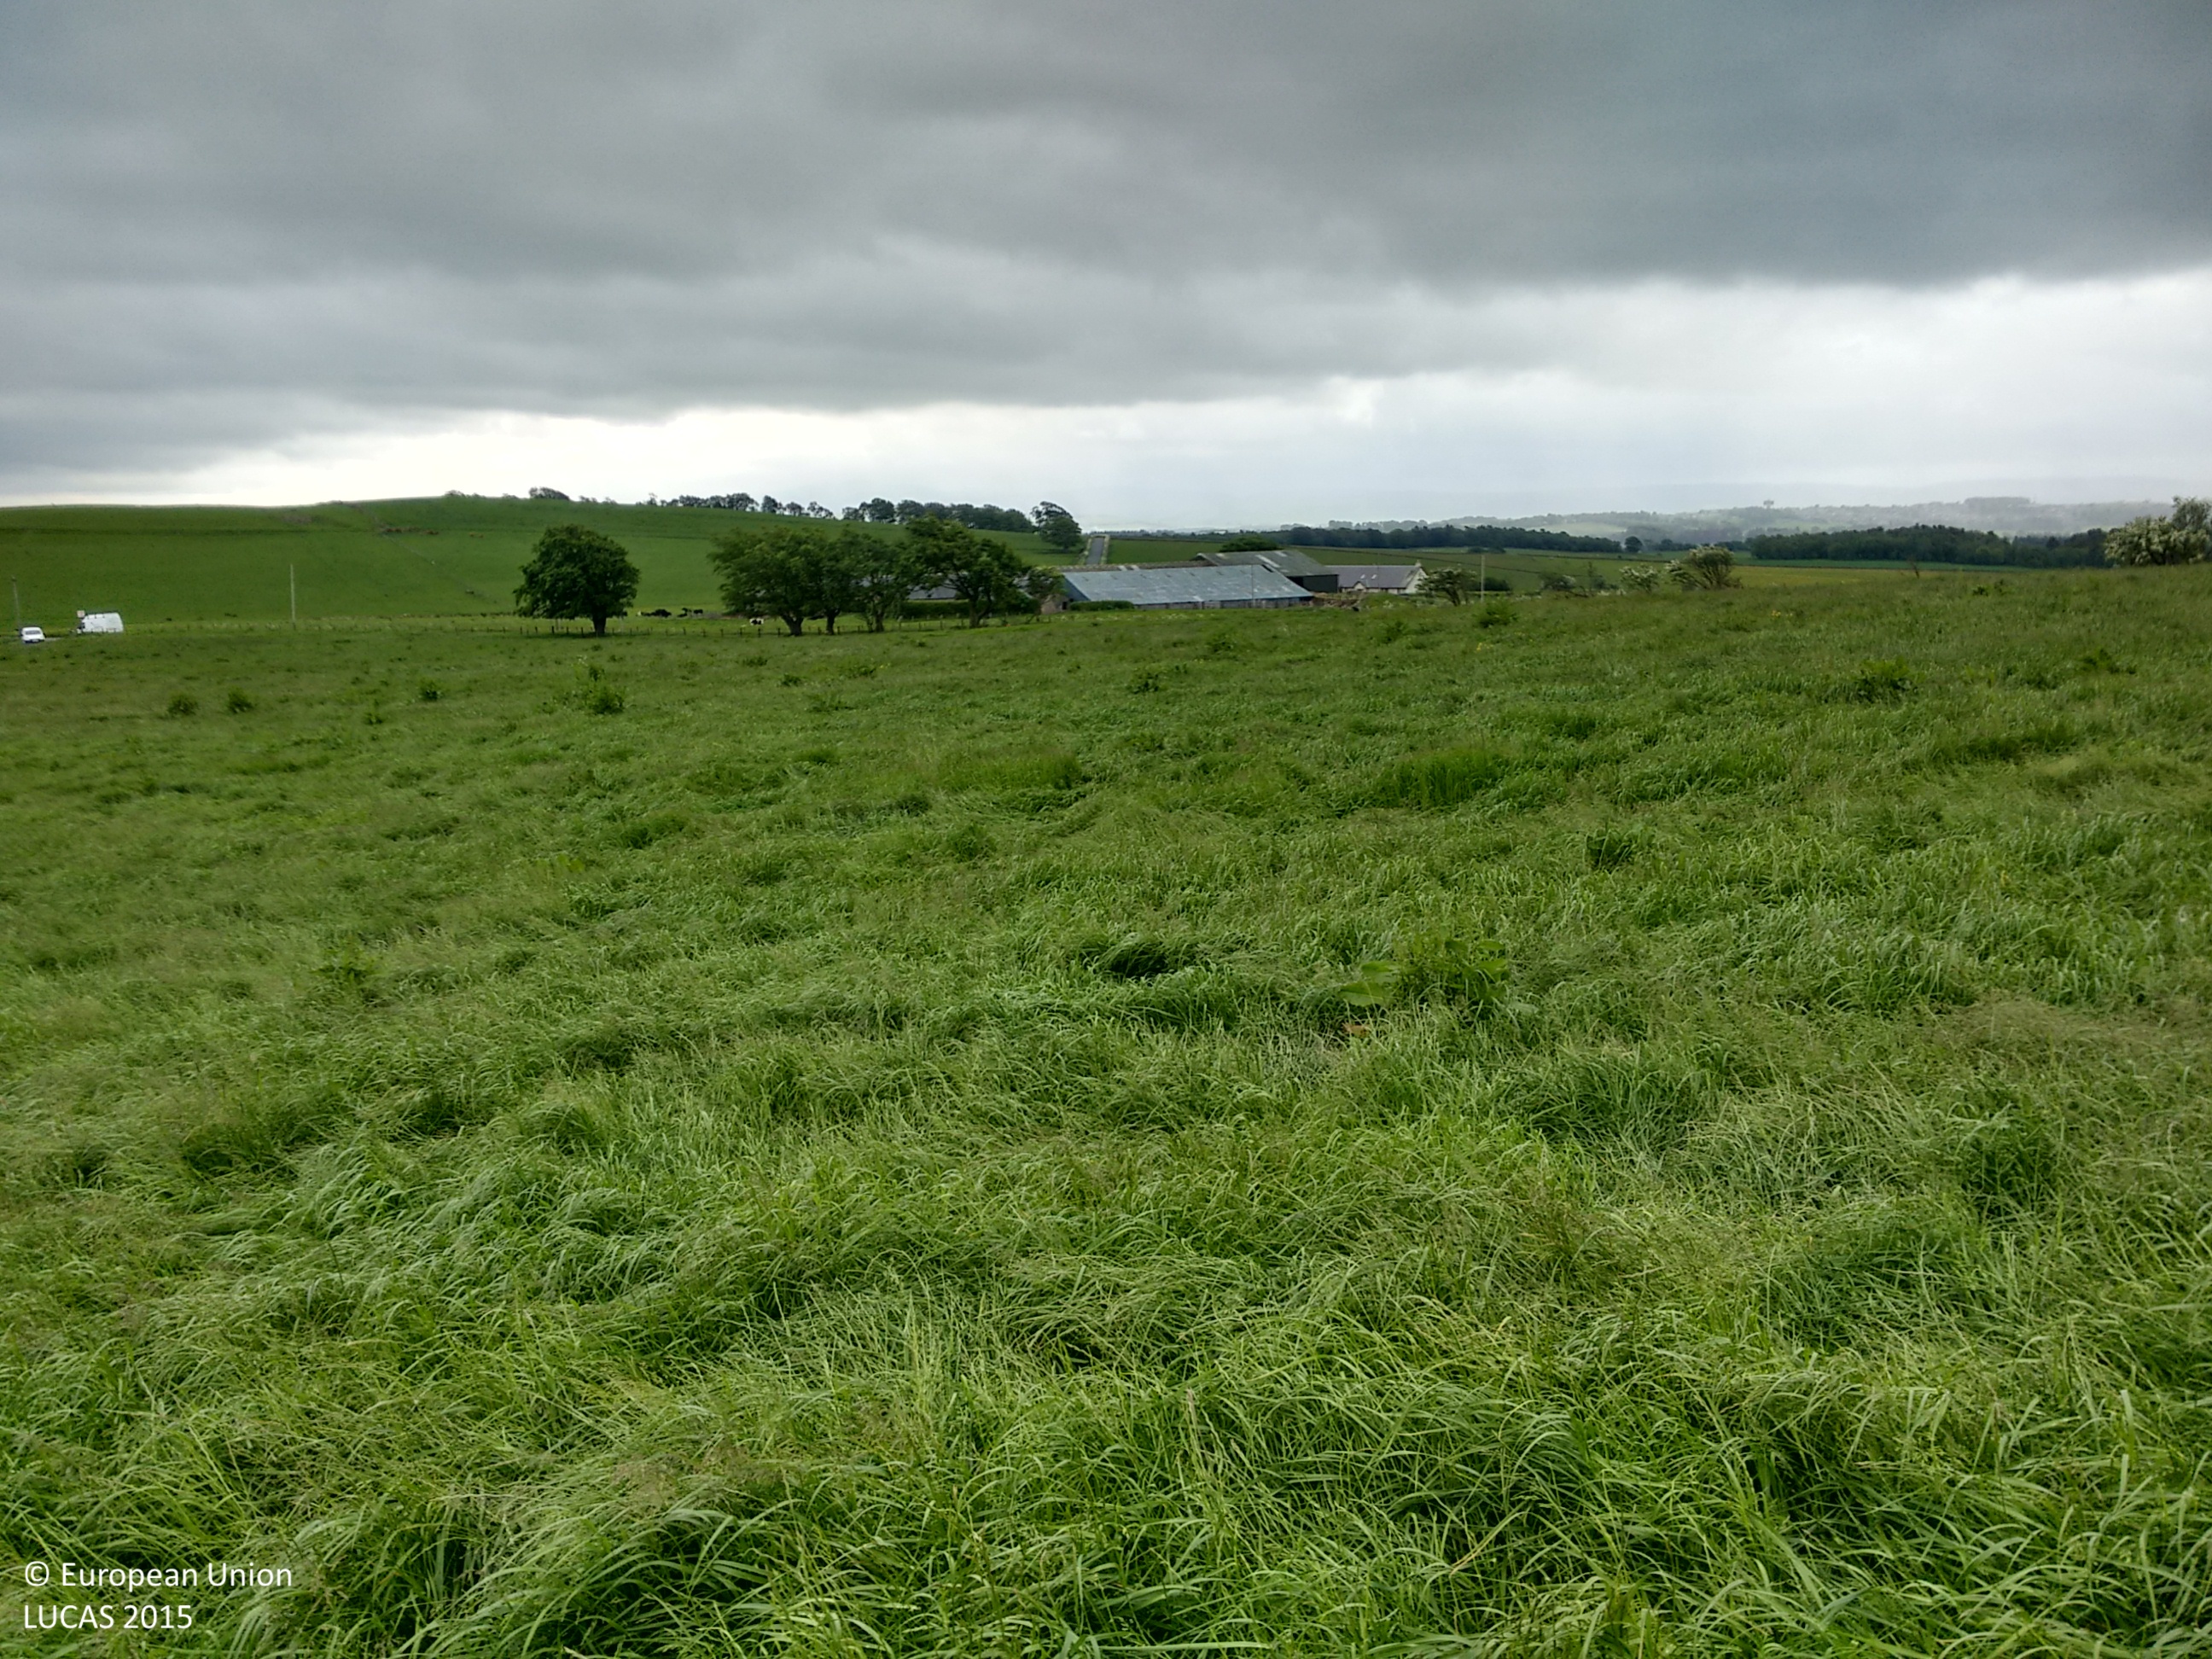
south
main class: Grassland
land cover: Grassland without tree/shrub cover
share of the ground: > 75 %
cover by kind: herbaceous plants 100 %
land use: Agriculture (excluding fallow land and kitchen gardens)
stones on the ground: < 10 %
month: June
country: GB
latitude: 55.7160
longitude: -3.7570
